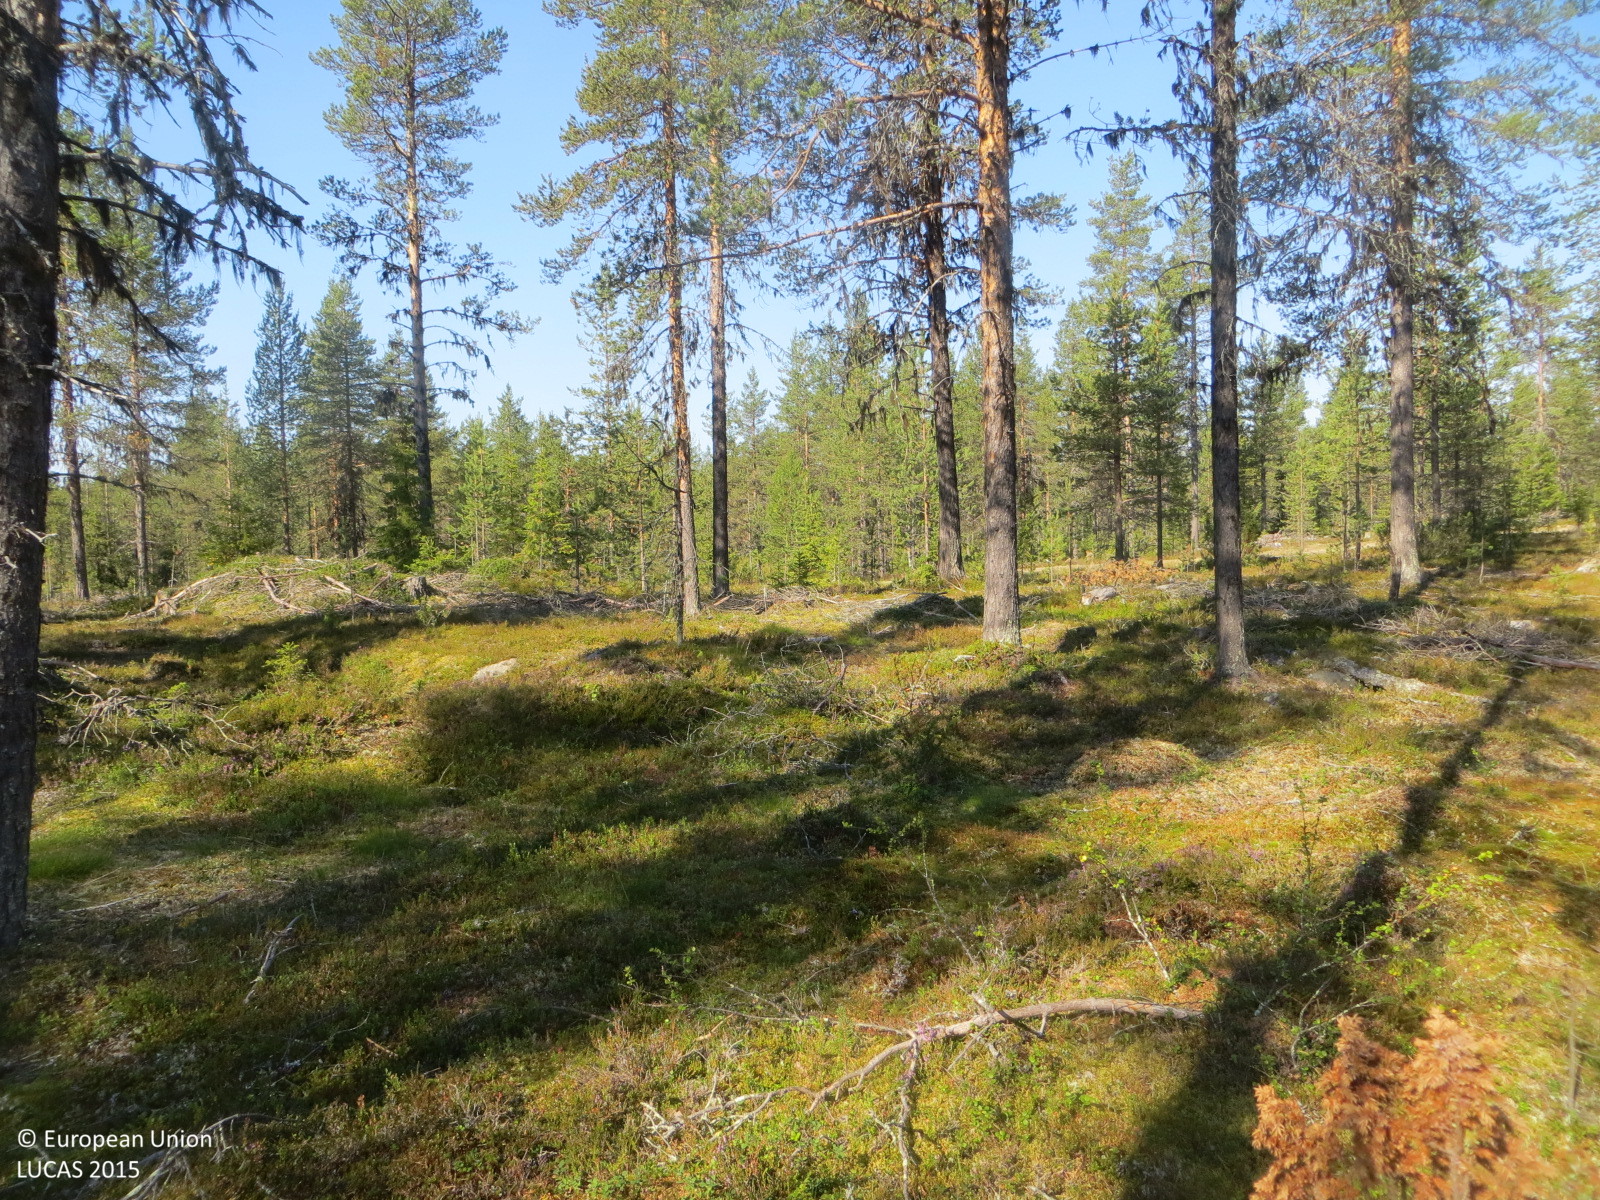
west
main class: Woodland
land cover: Pine dominated coniferous woodland
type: boreal forest
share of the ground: 50 - 75 %
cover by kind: coniferous forest trees 50 %, shrubs 50 %
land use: Forestry
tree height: > 5 m
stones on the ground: < 10 %
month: August
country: FI
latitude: 67.7104
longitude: 24.1264
